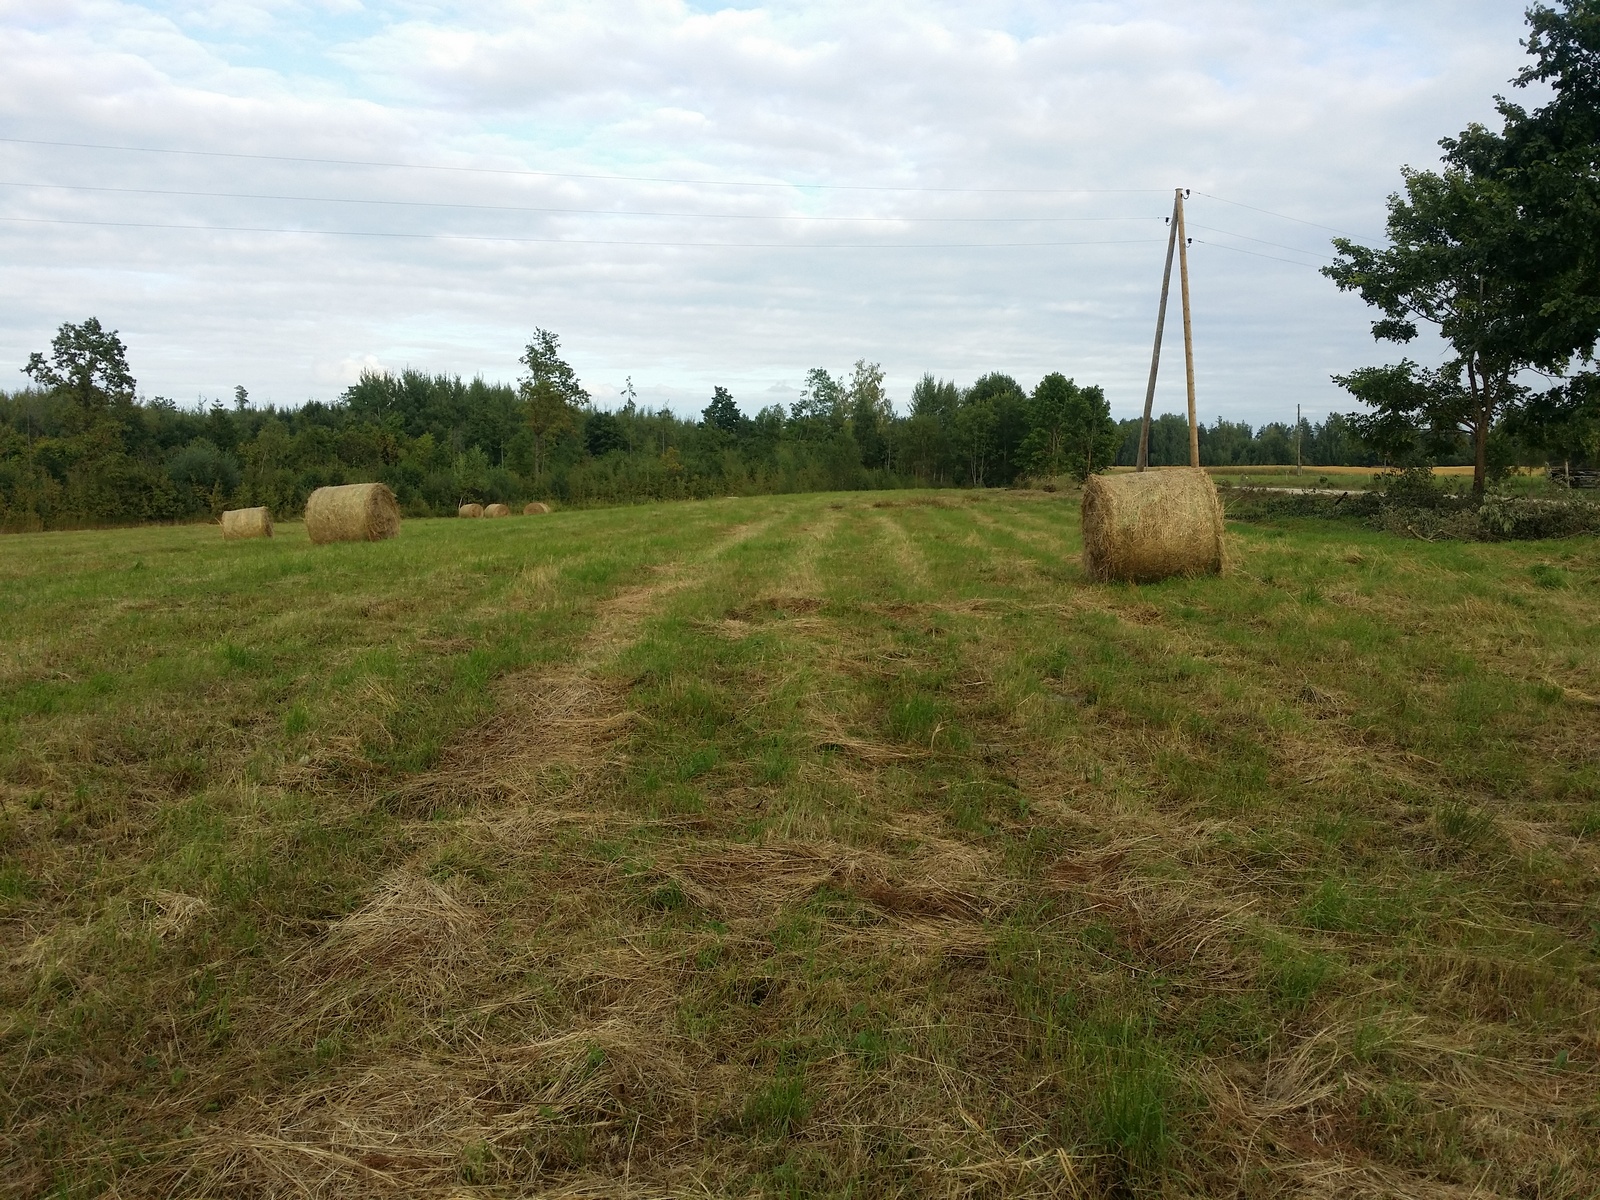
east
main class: Grassland
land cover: Grassland without tree/shrub cover
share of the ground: > 75 %
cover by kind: herbaceous plants 90 %, unconsolidated bare surface 10 %
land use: Agriculture (excluding fallow land and kitchen gardens)
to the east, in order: Grassland without tree/shrub cover; Electric lines; Grassland without tree/shrub cover; Grass margins; Ditches and canals; Broadleaved woodland
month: August
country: LV
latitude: 56.9474
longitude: 27.2155
